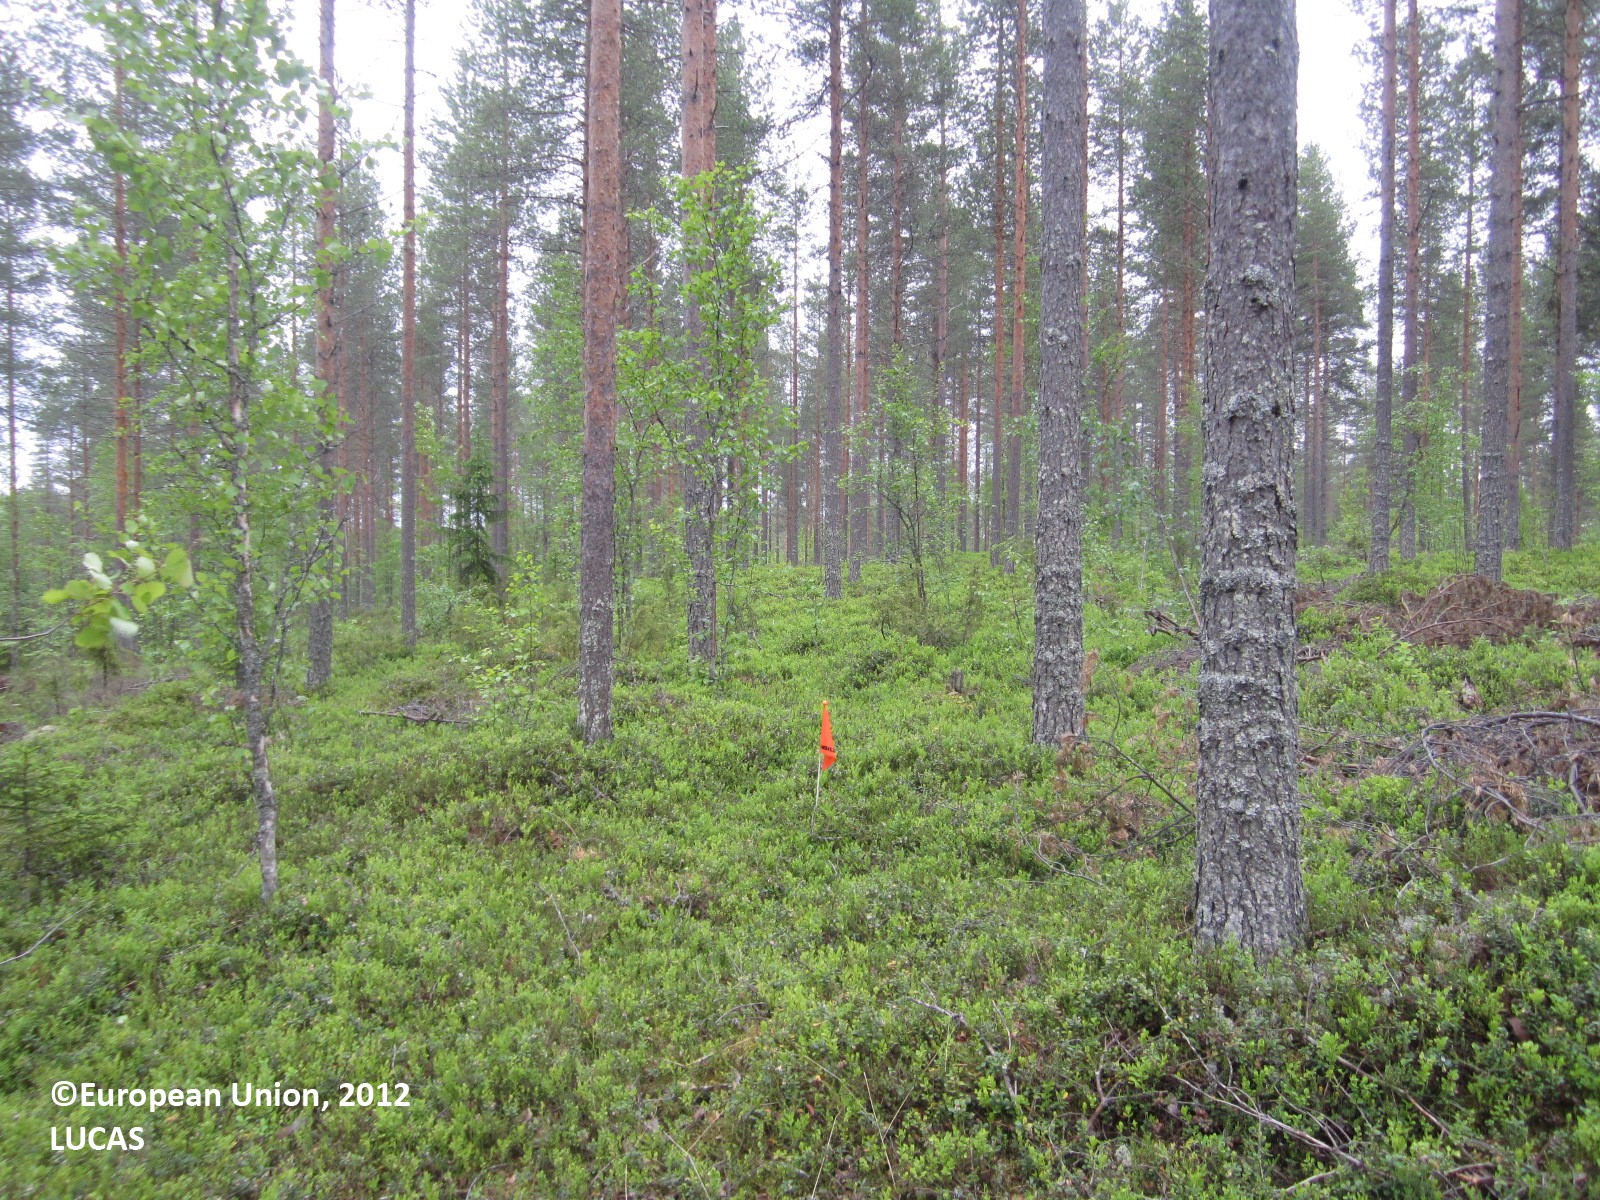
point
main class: Woodland
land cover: Pine dominated coniferous woodland
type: boreal forest
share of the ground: 50 - 75 %
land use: Forestry
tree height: > 5 m
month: June
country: FI
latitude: 64.4580
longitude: 29.5258
